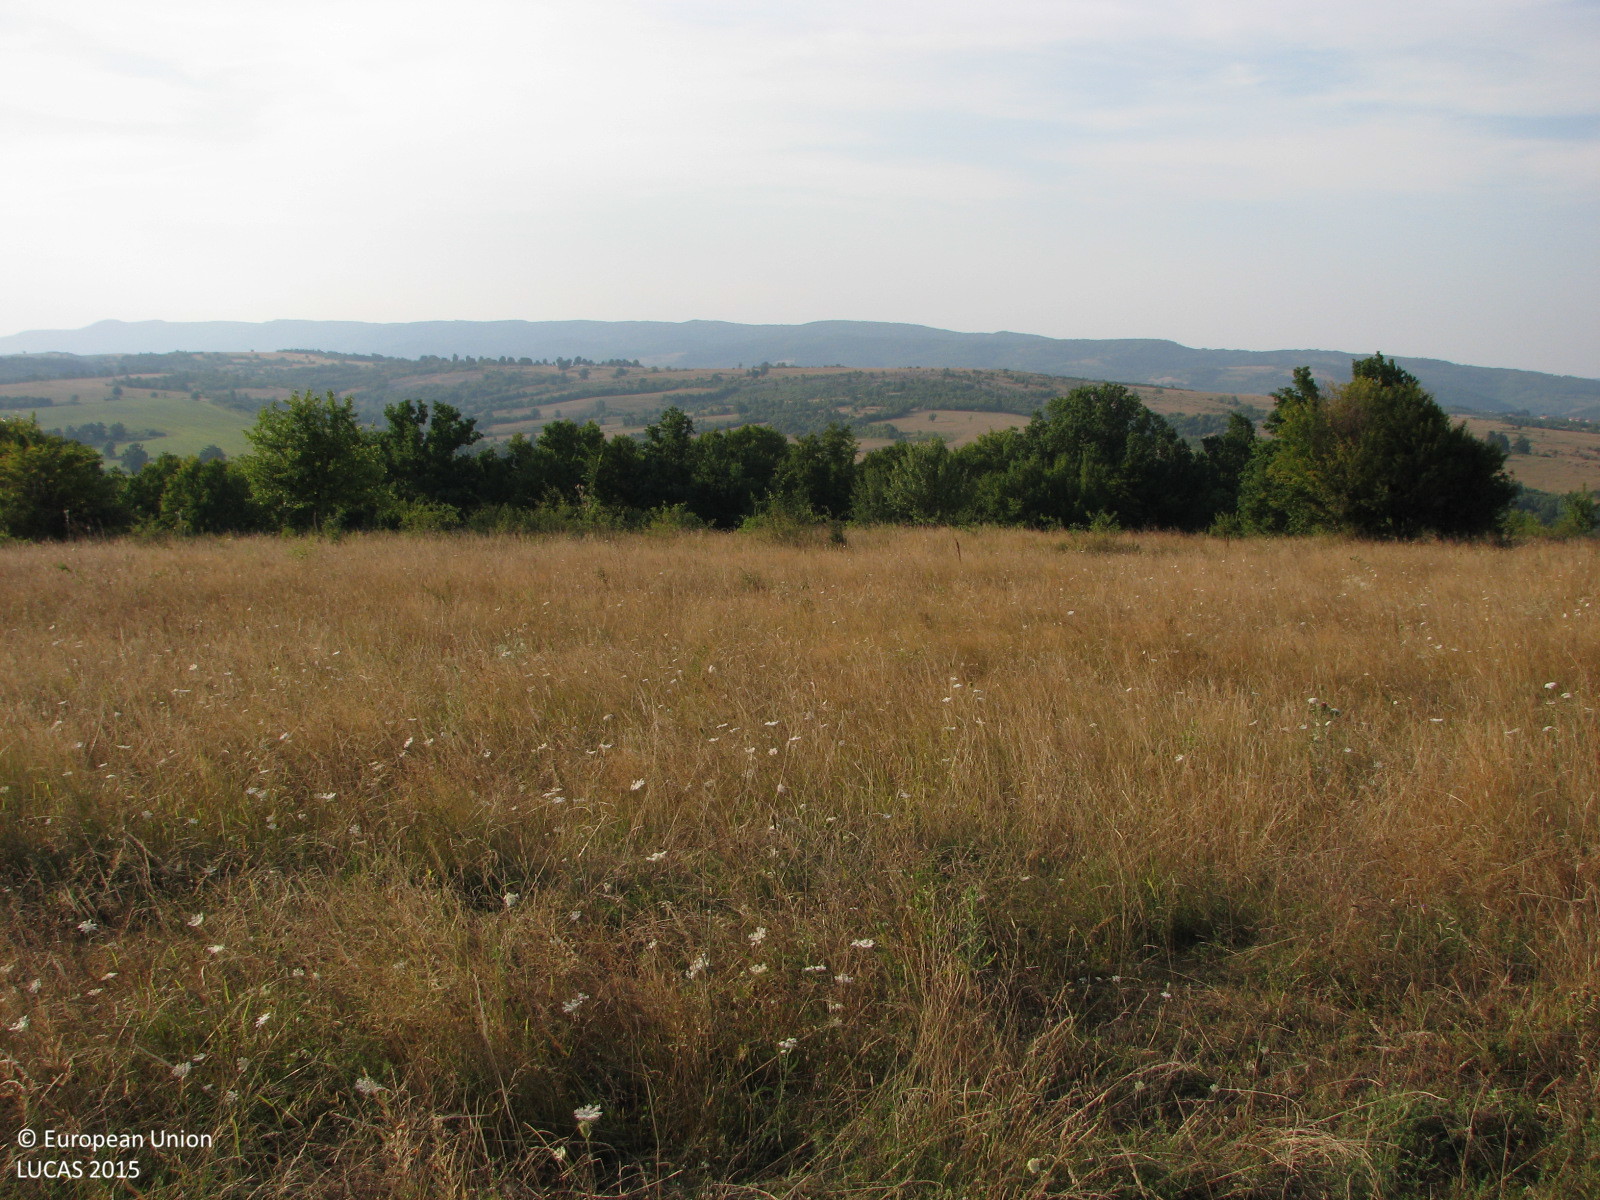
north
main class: Grassland
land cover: Grassland without tree/shrub cover
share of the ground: > 75 %
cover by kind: herbaceous plants 100 %
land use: Agriculture (excluding fallow land and kitchen gardens)
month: August
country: BG
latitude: 42.8929
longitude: 26.1427
